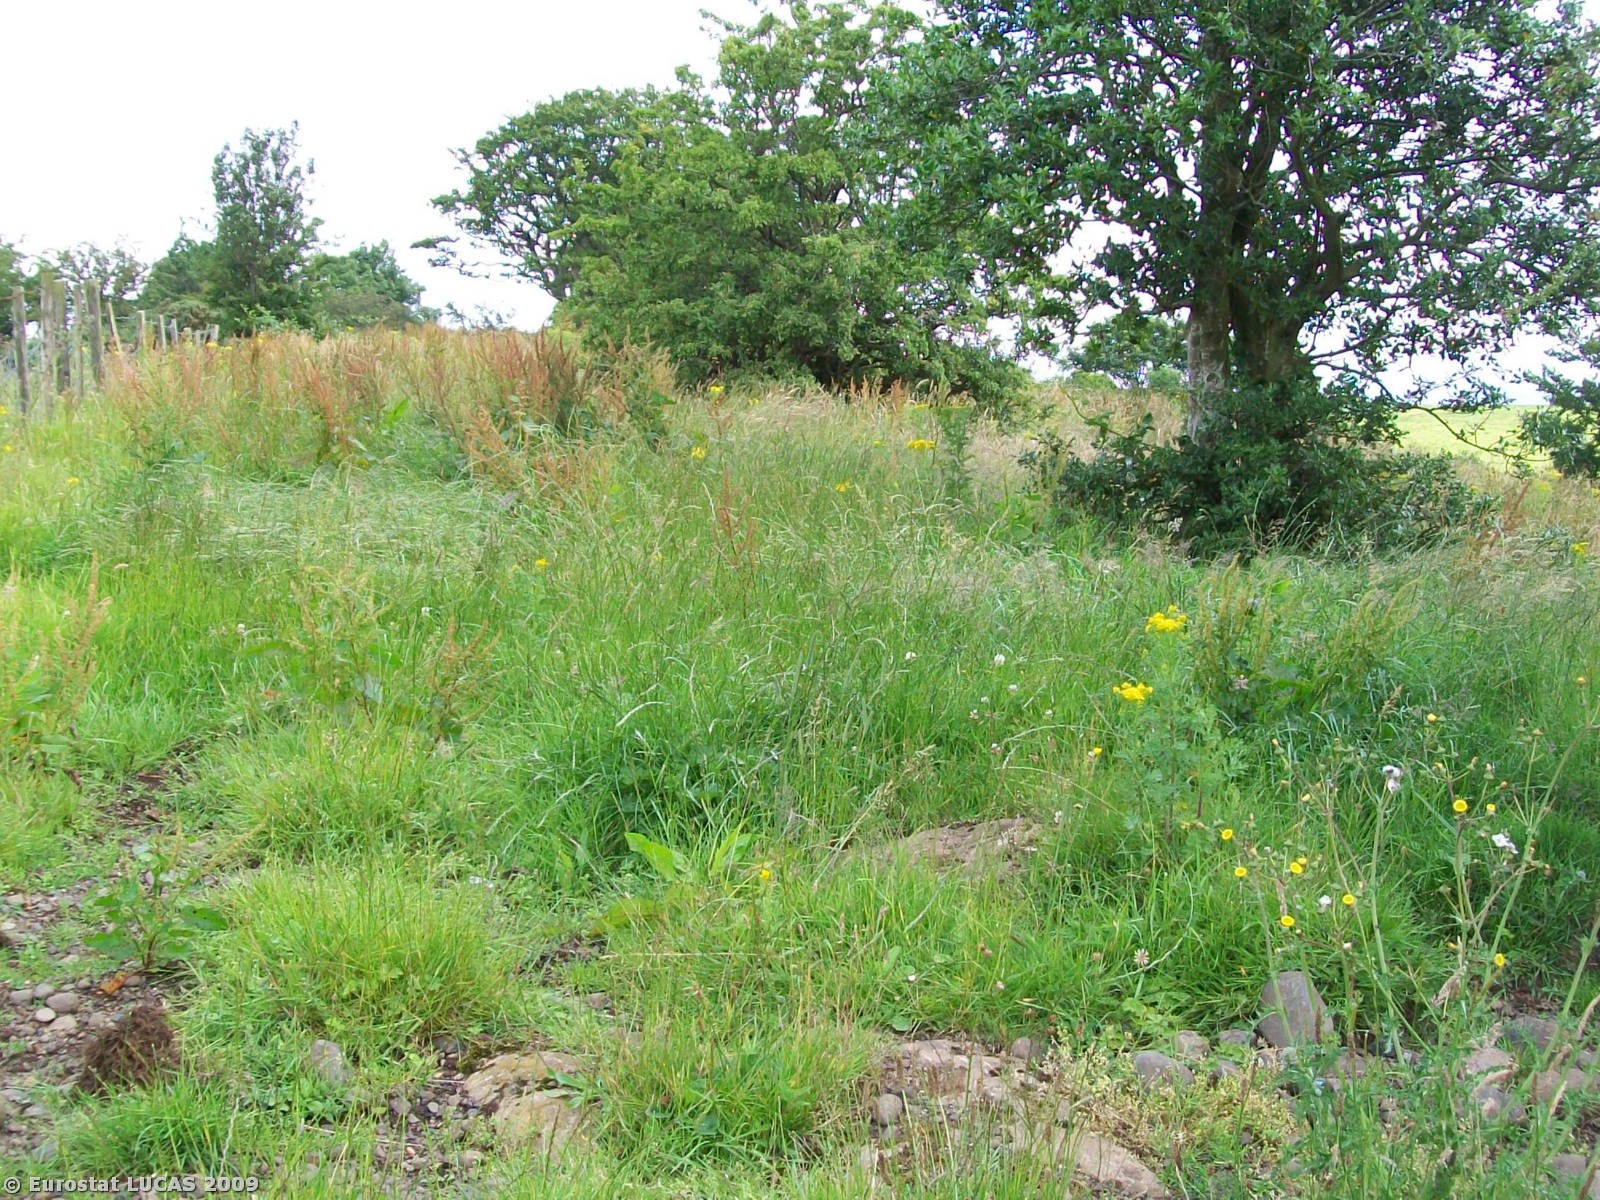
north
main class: Grassland
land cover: Grassland with sparse tree/shrub cover
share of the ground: > 75 %
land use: Agriculture (excluding fallow land and kitchen gardens)
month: July
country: GB
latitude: 54.9579
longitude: -6.2474
